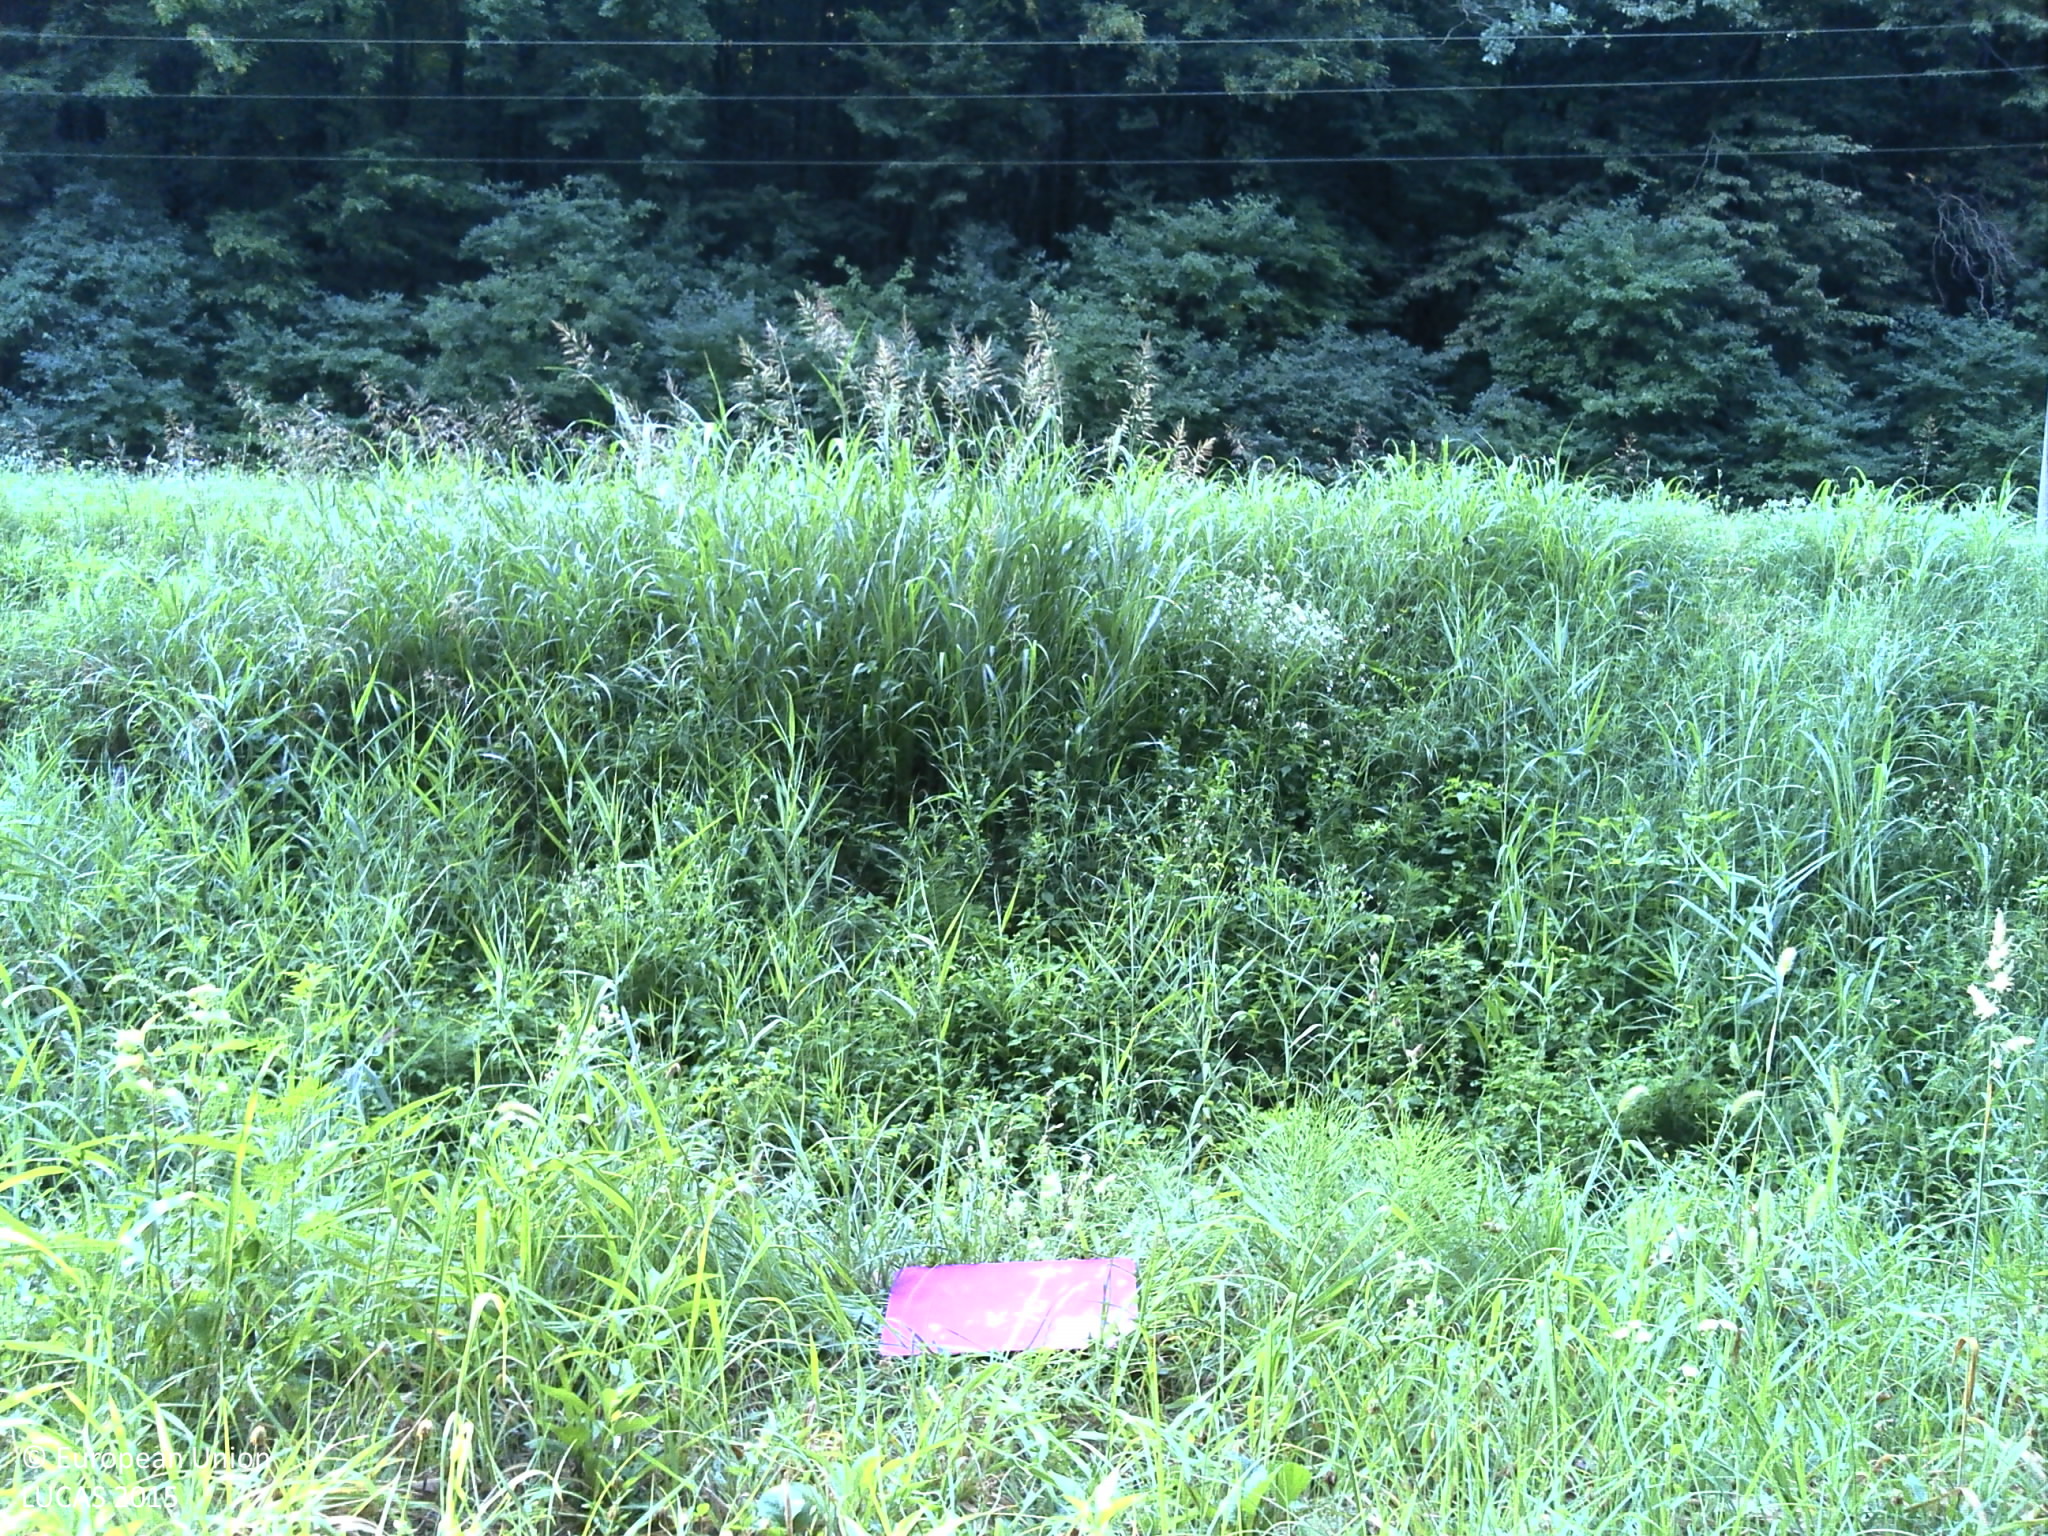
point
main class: Grassland
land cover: Spontaneously vegetated surfaces
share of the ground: > 75 %
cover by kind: herbaceous plants 100 %
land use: Road transport
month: August
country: HR
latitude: 45.9575
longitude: 17.2922
